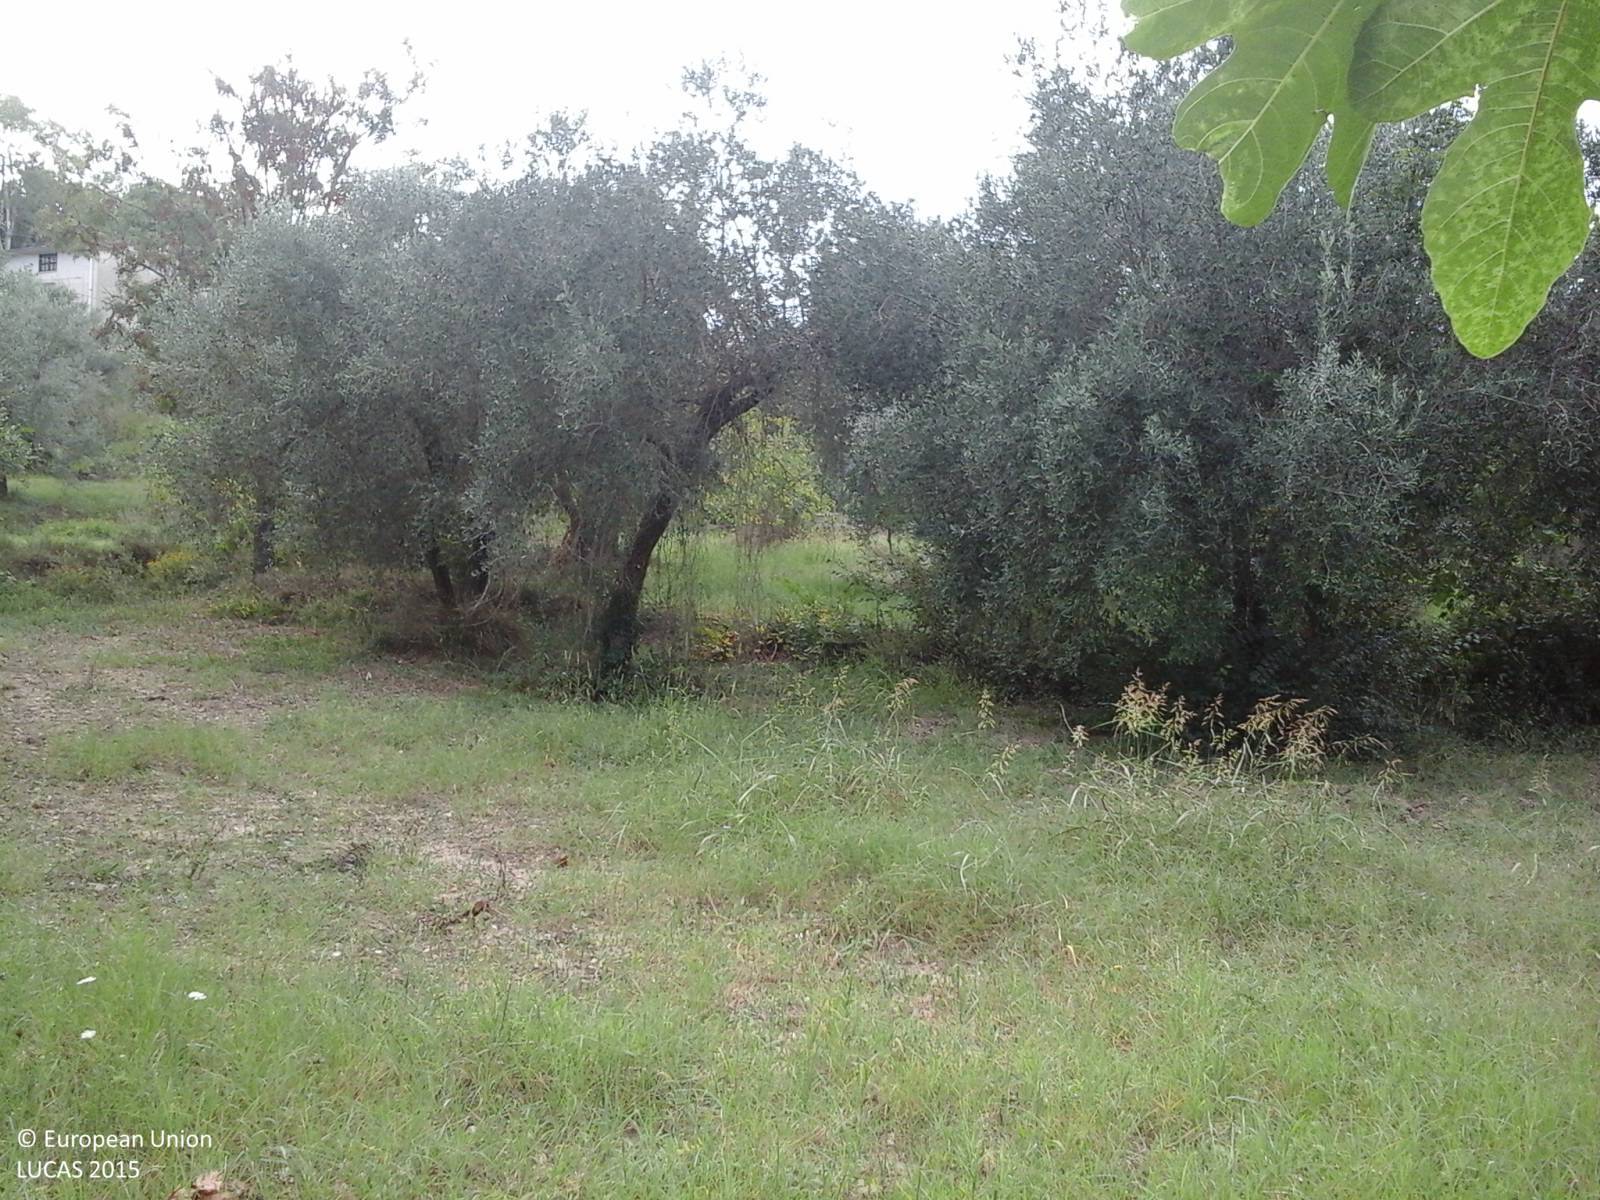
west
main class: Grassland
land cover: Spontaneously vegetated surfaces
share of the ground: > 75 %
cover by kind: herbaceous plants 100 %
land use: Agriculture (excluding fallow land and kitchen gardens)
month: September
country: IT
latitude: 41.2634
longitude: 13.7688
